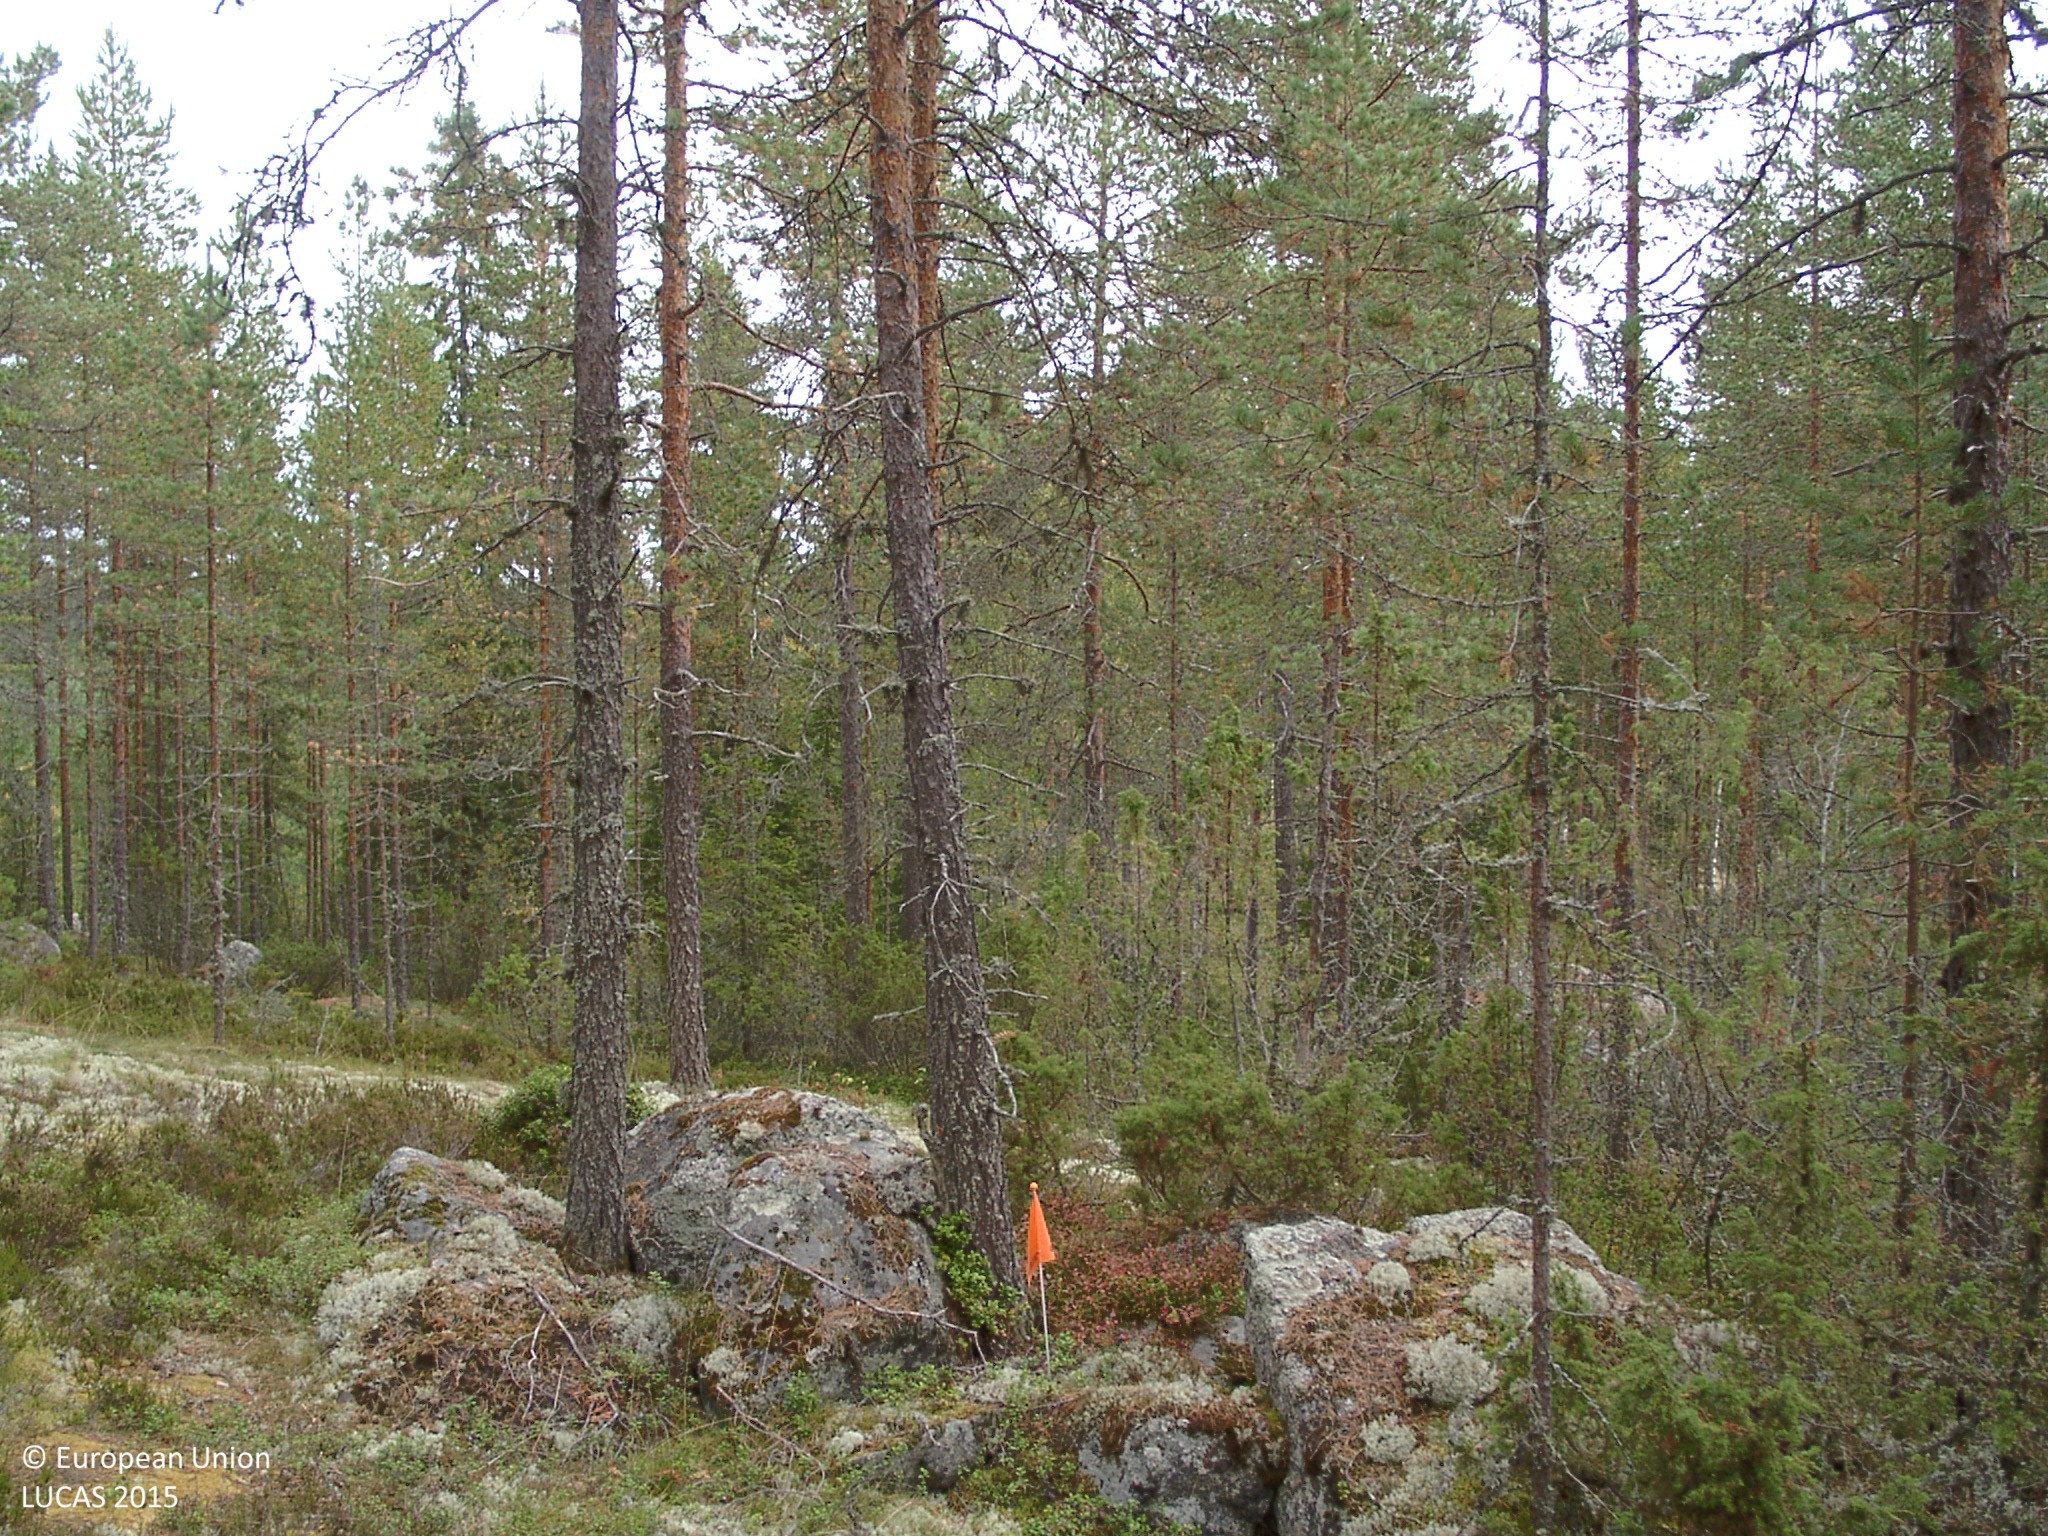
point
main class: Woodland
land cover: Pine dominated coniferous woodland
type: boreal forest
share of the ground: 25 - 50 %
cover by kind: lichens and mosses 45 %, shrubs 30 %, coniferous forest trees 25 %
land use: Forestry
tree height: > 5 m
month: September
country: FI
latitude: 62.5312
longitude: 25.7612
